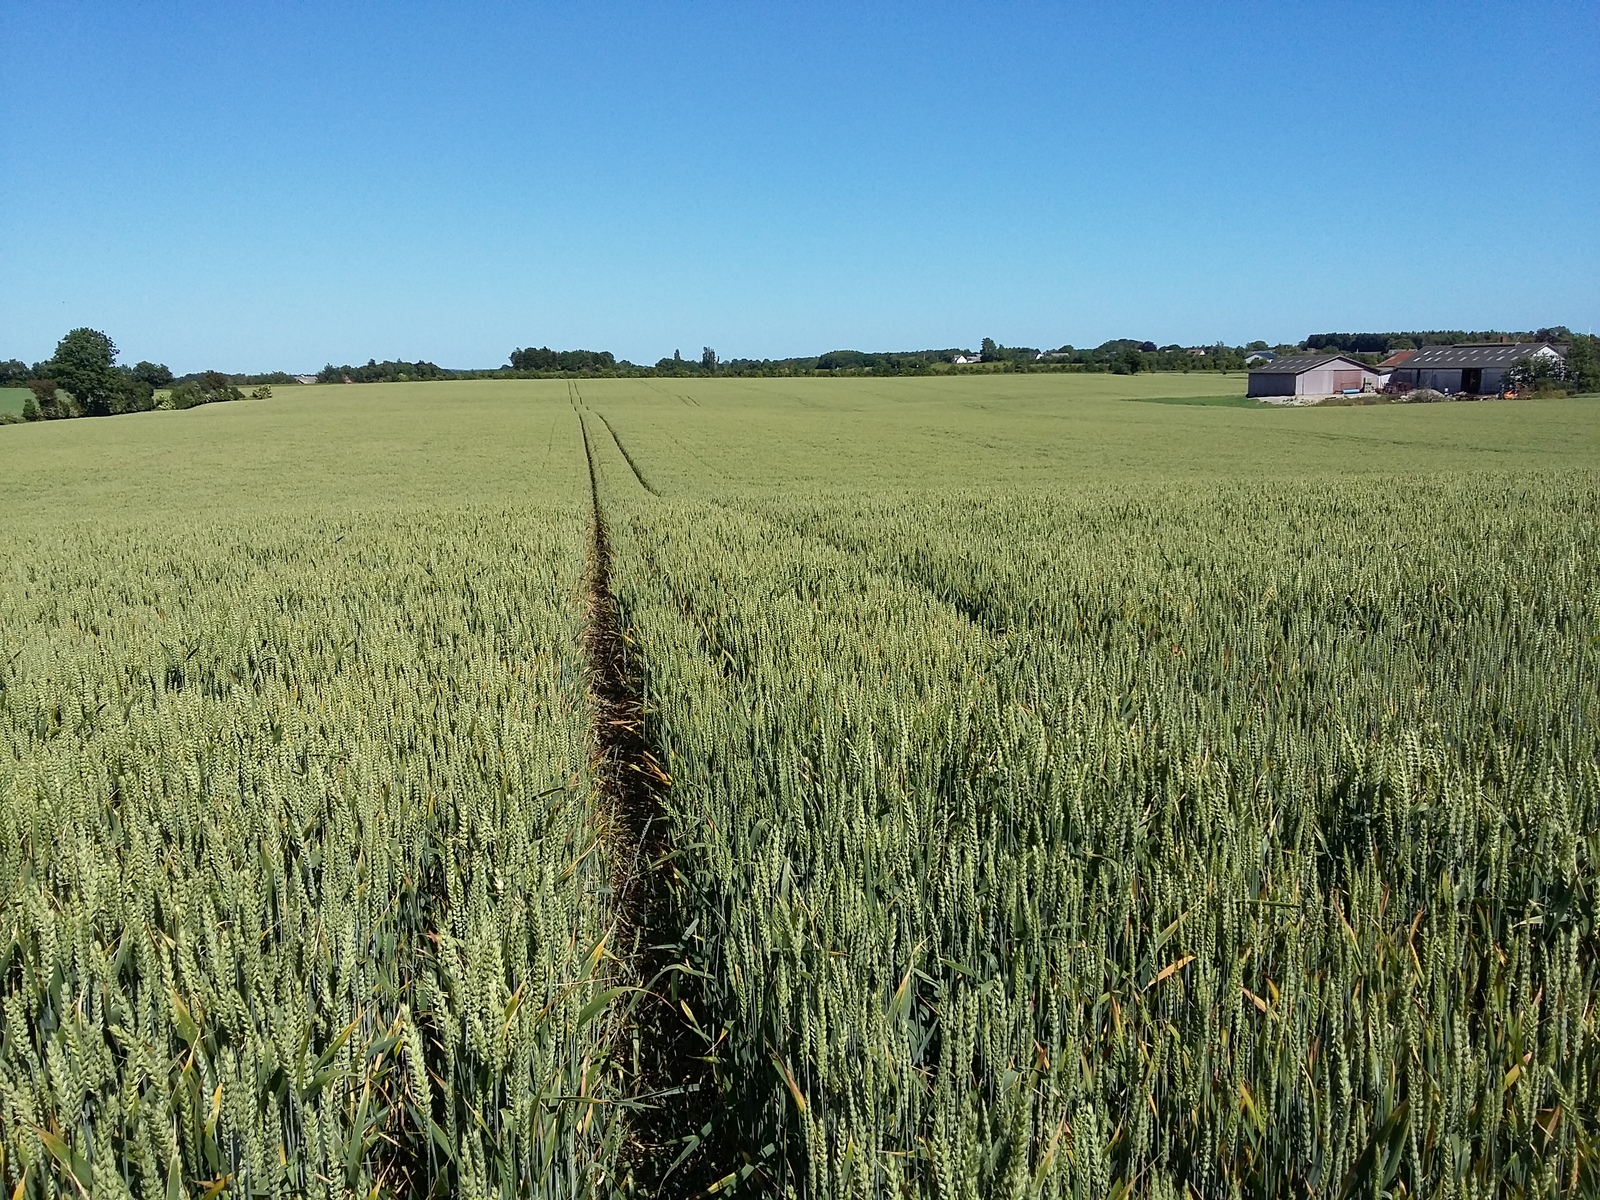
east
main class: Cropland
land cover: Common wheat
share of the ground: > 75 %
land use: Agriculture (excluding fallow land and kitchen gardens)
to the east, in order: Common wheat
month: July
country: DK
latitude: 54.9288
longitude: 12.1678
